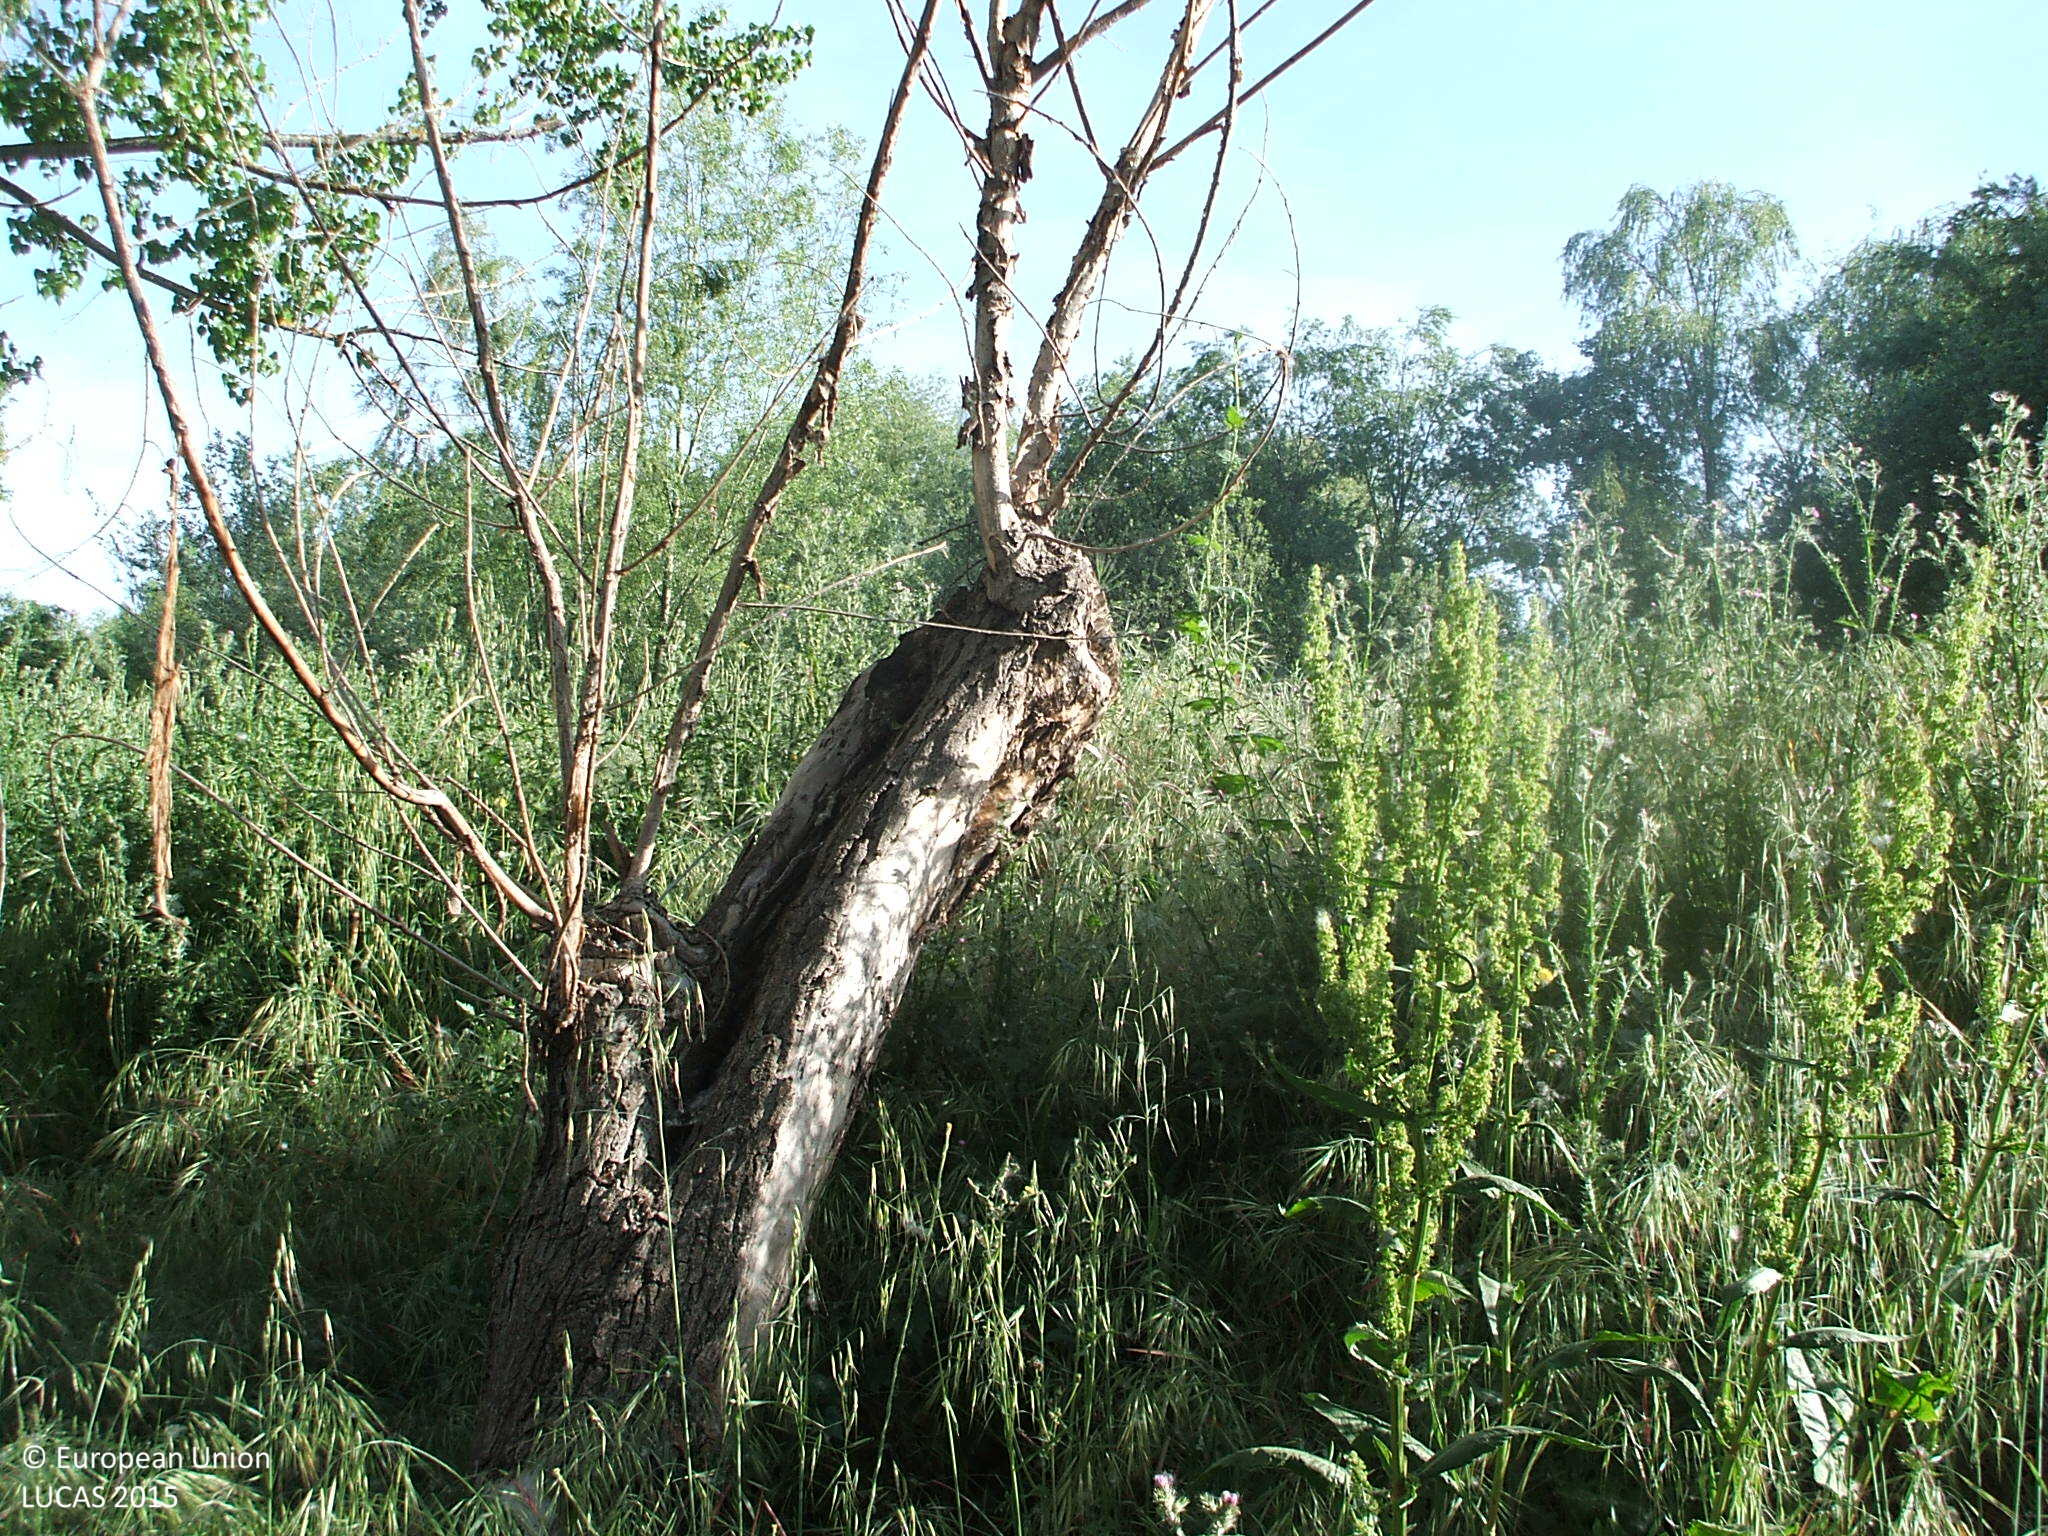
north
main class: Woodland
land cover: Broadleaved woodland
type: floodplain forest
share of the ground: 50 - 75 %
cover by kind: broadleaved forest trees 70 %, herbaceous plants 30 %
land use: Semi-natural and natural areas not in use
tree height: > 5 m
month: May
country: ES
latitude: 40.6839
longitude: -3.3714
